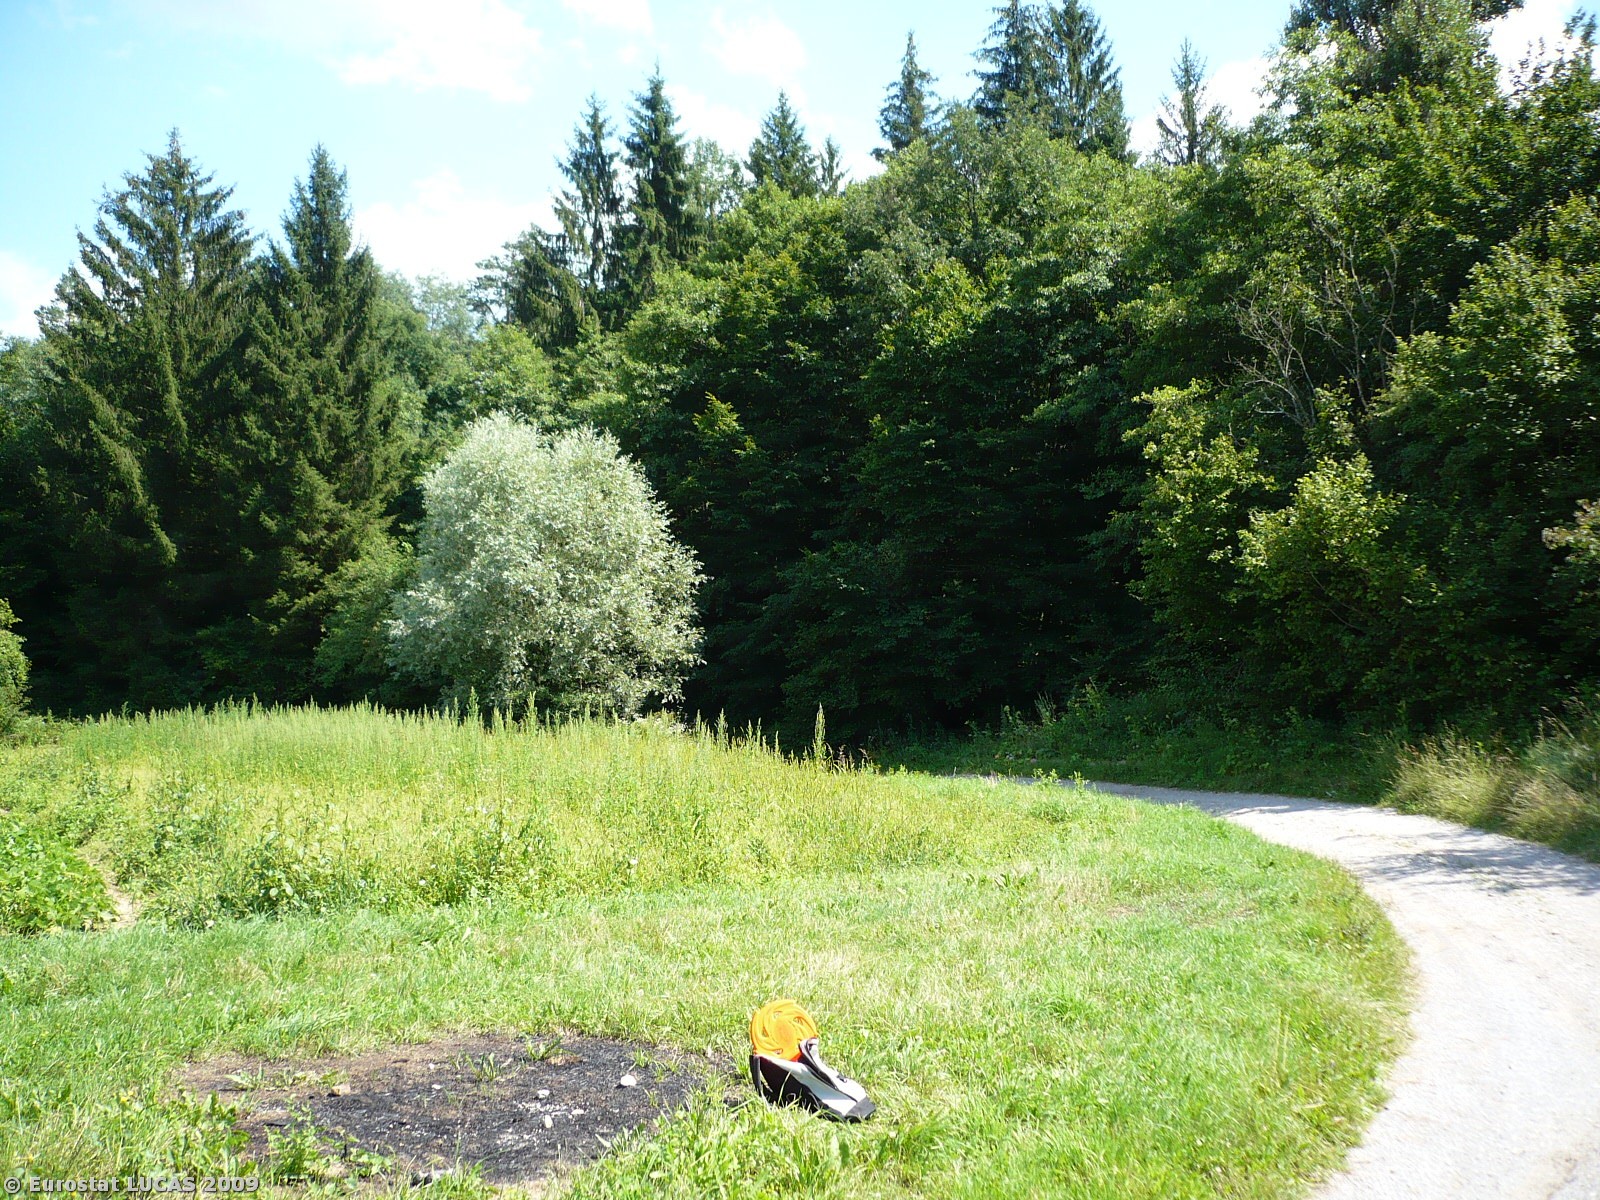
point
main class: Grassland
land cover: Grassland without tree/shrub cover
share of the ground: > 75 %
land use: Agriculture (excluding fallow land and kitchen gardens)
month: July
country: SI
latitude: 45.5838
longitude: 14.1865
